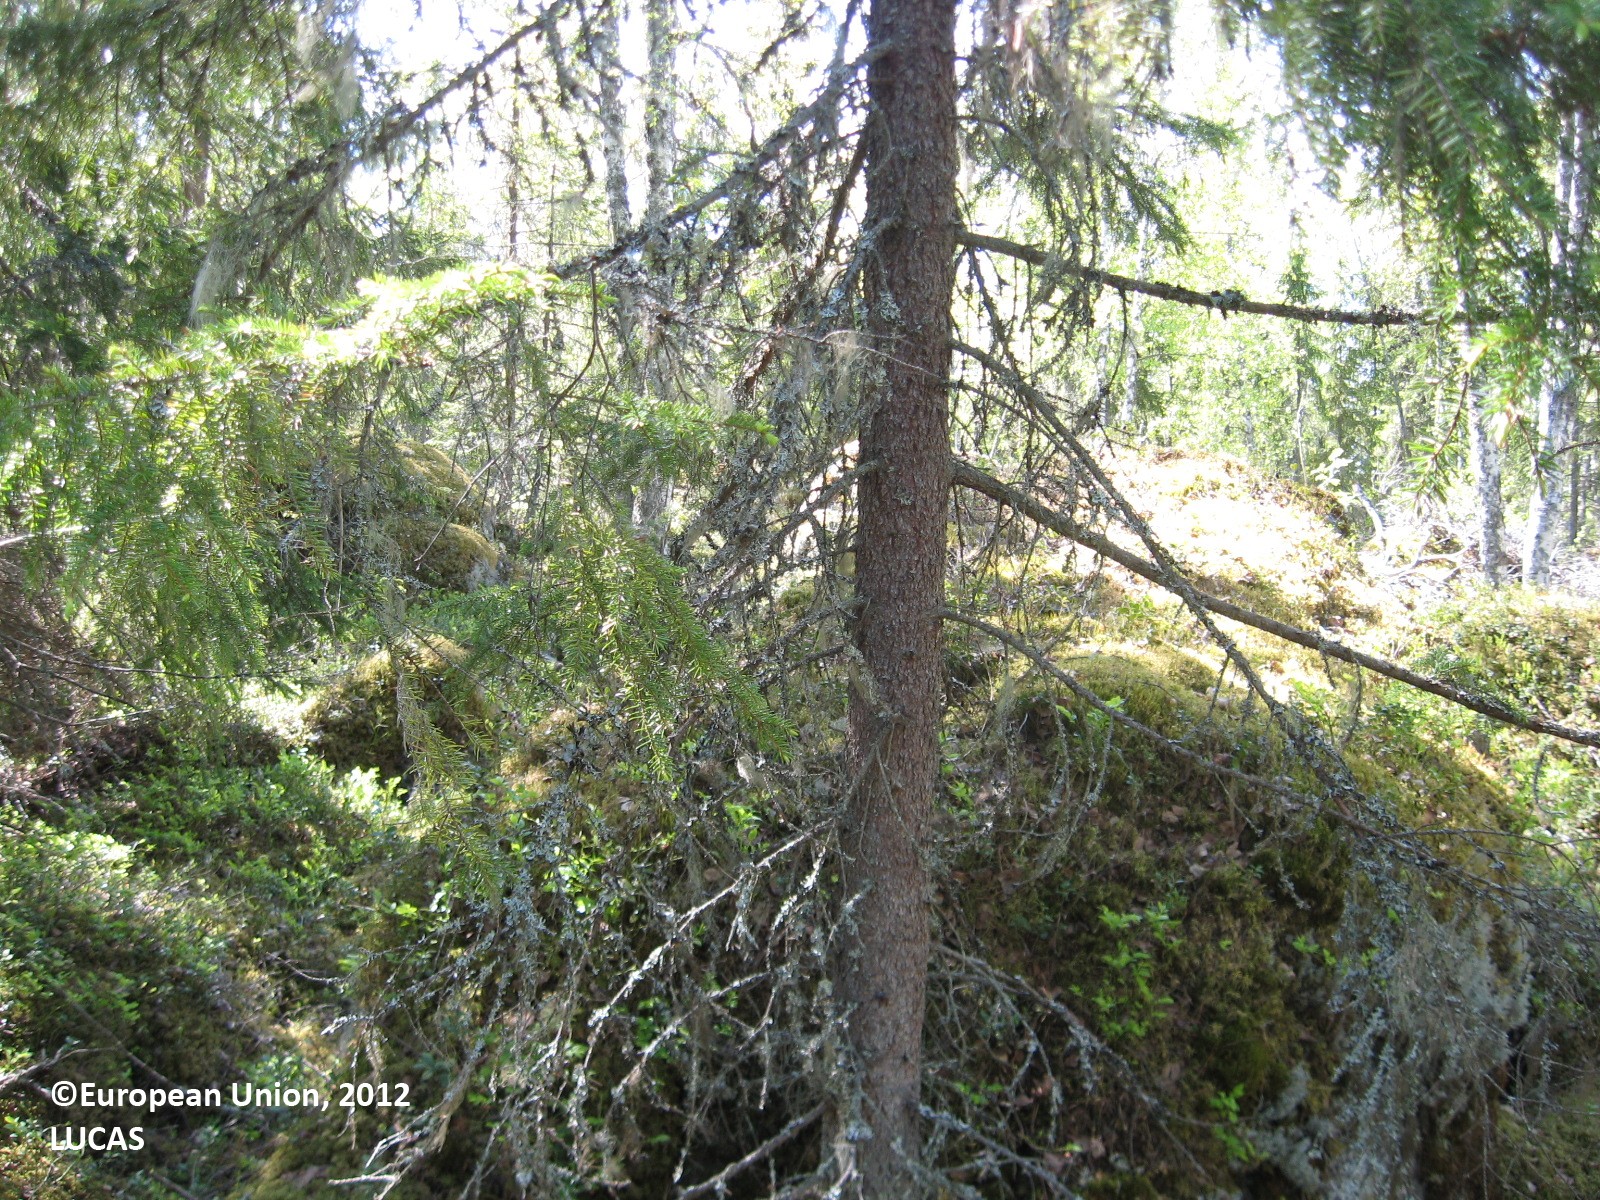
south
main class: Woodland
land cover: Spruce dominated coniferous woodland
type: boreal forest
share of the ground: 50 - 75 %
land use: Forestry
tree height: > 5 m
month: June
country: FI
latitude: 63.1569
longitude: 21.7326
